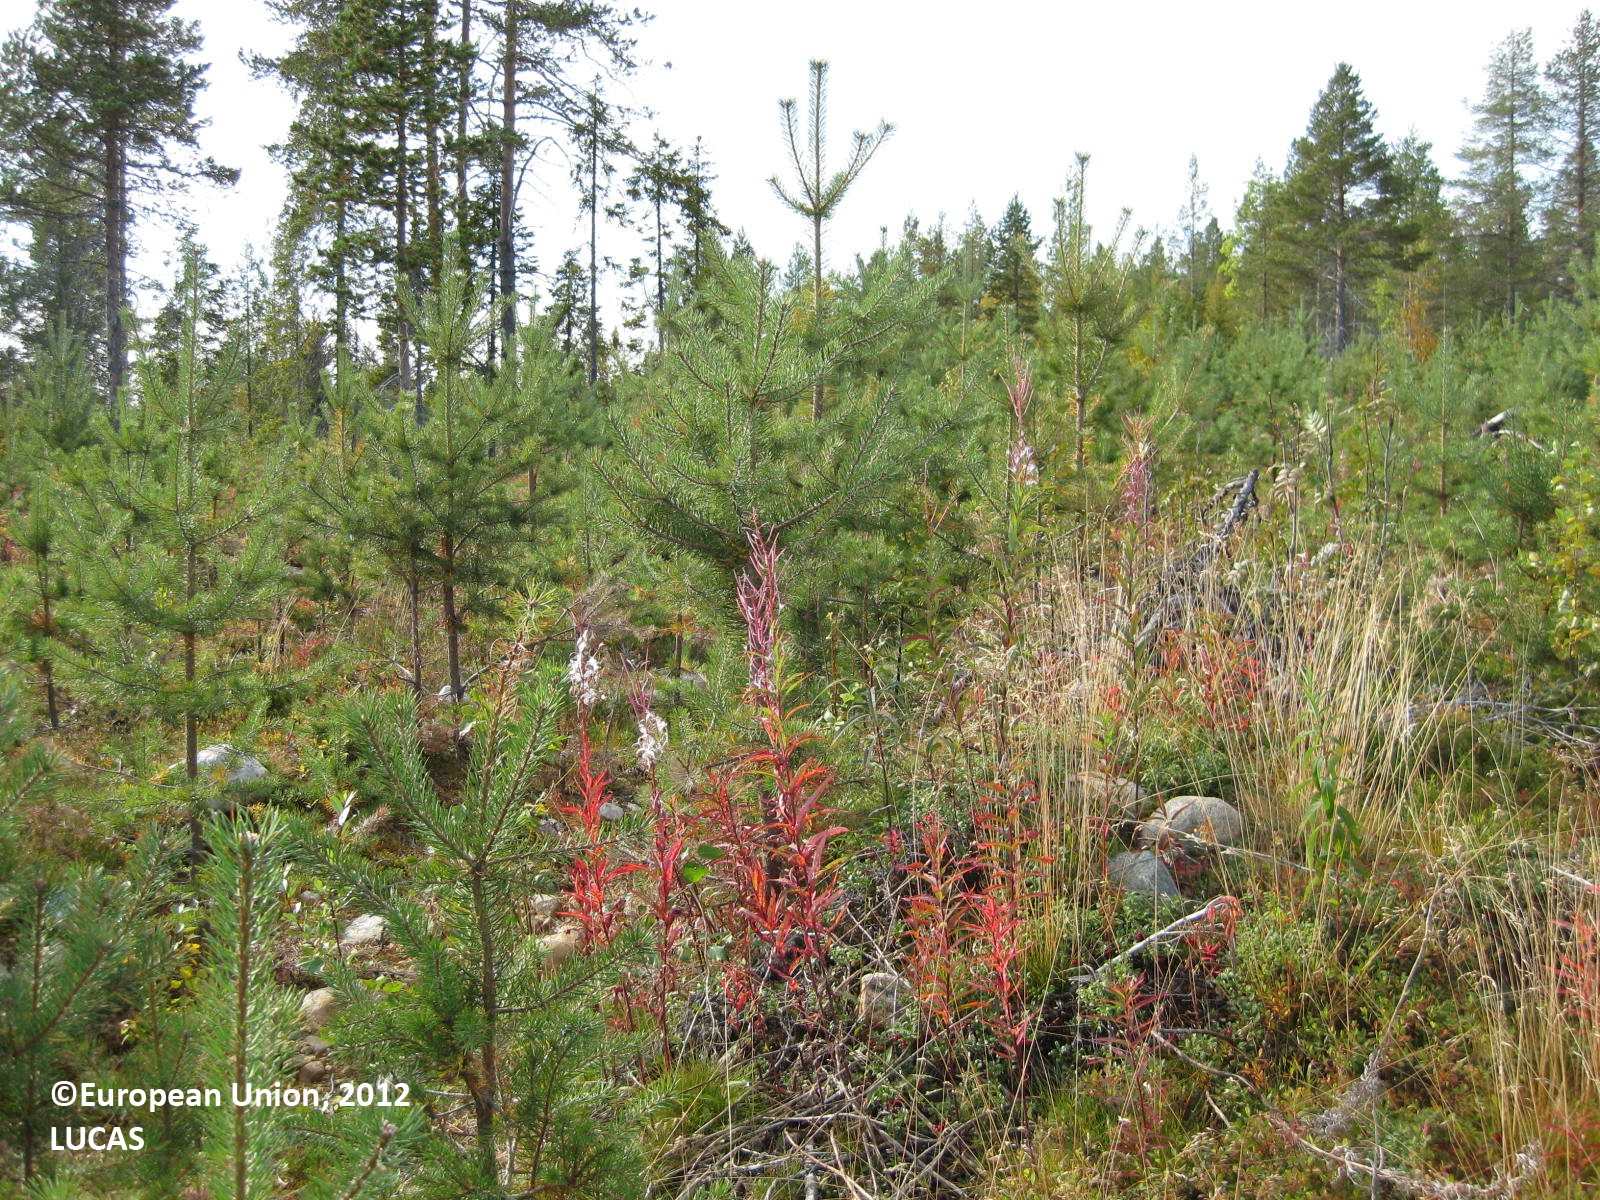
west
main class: Woodland
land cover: Pine dominated coniferous woodland
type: boreal forest
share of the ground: 50 - 75 %
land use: Forestry
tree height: < 5 m
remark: Clear cut
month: August
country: FI
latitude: 65.8890
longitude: 28.7002
